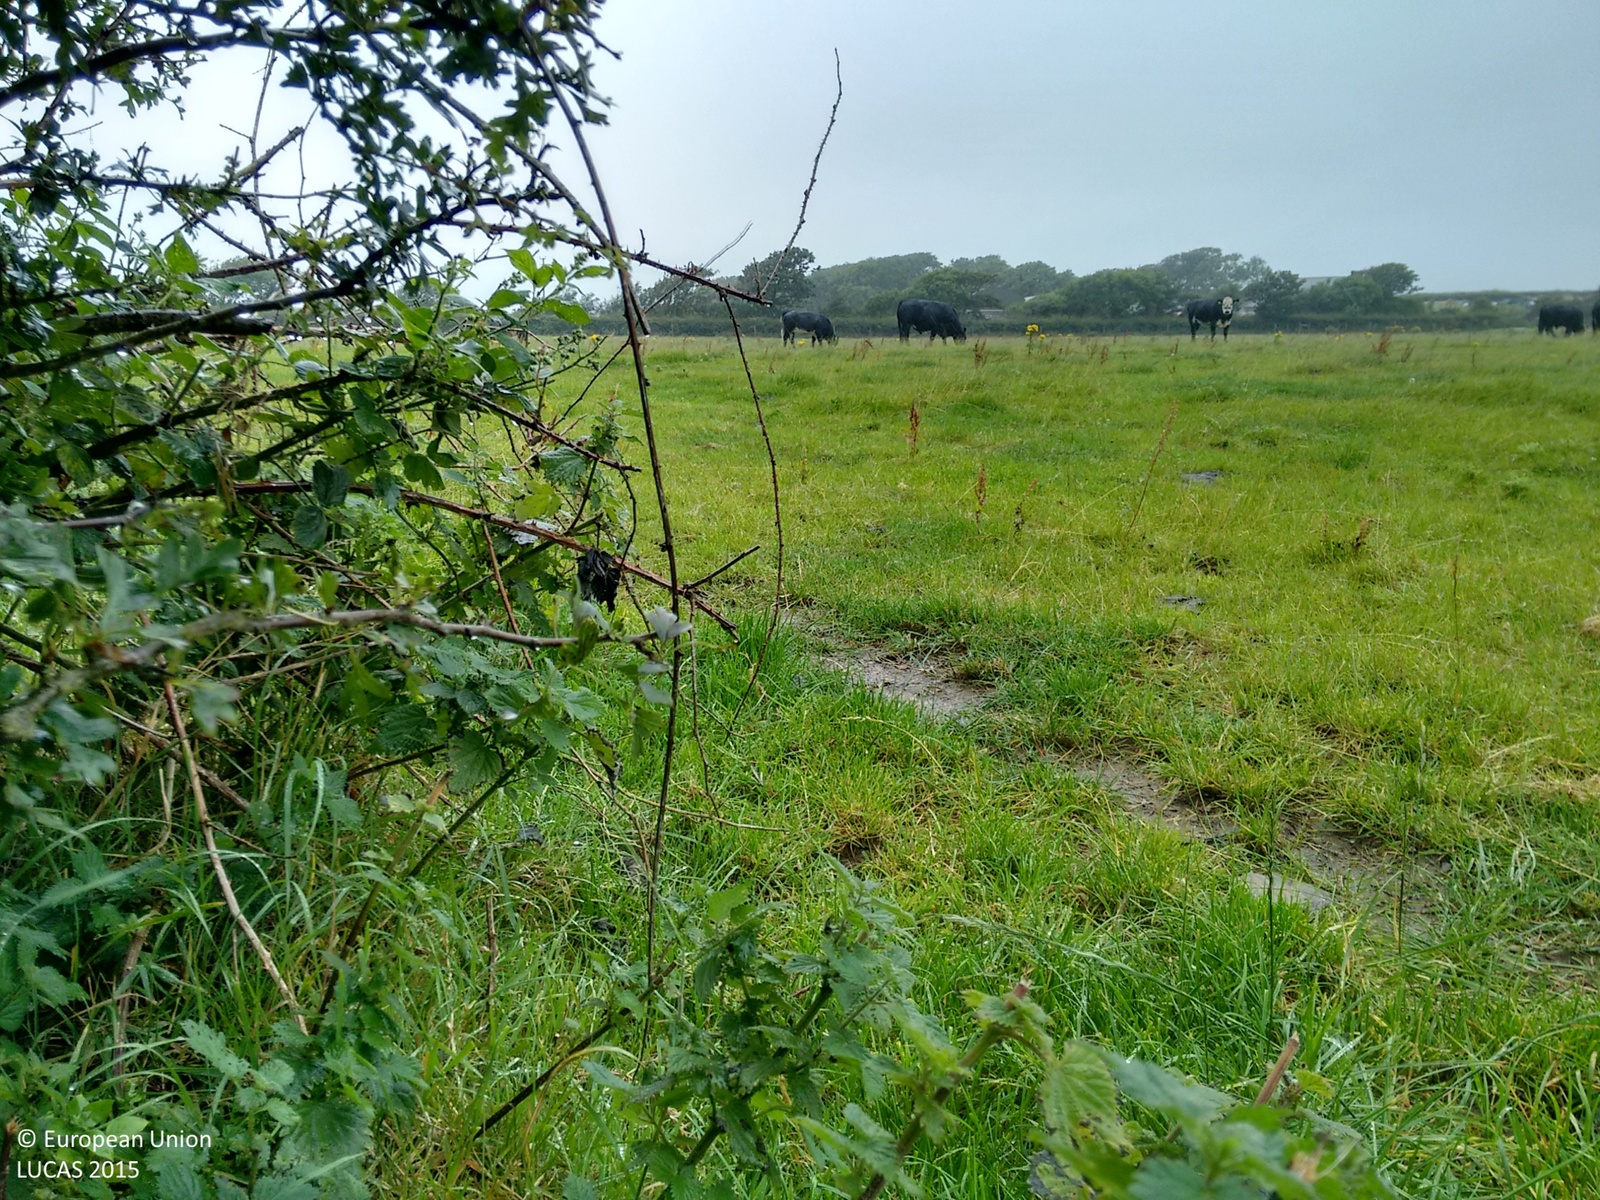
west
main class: Grassland
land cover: Grassland without tree/shrub cover
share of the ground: > 75 %
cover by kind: herbaceous plants 100 %
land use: Agriculture (excluding fallow land and kitchen gardens)
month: August
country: GB
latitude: 54.2716
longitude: -5.5936
